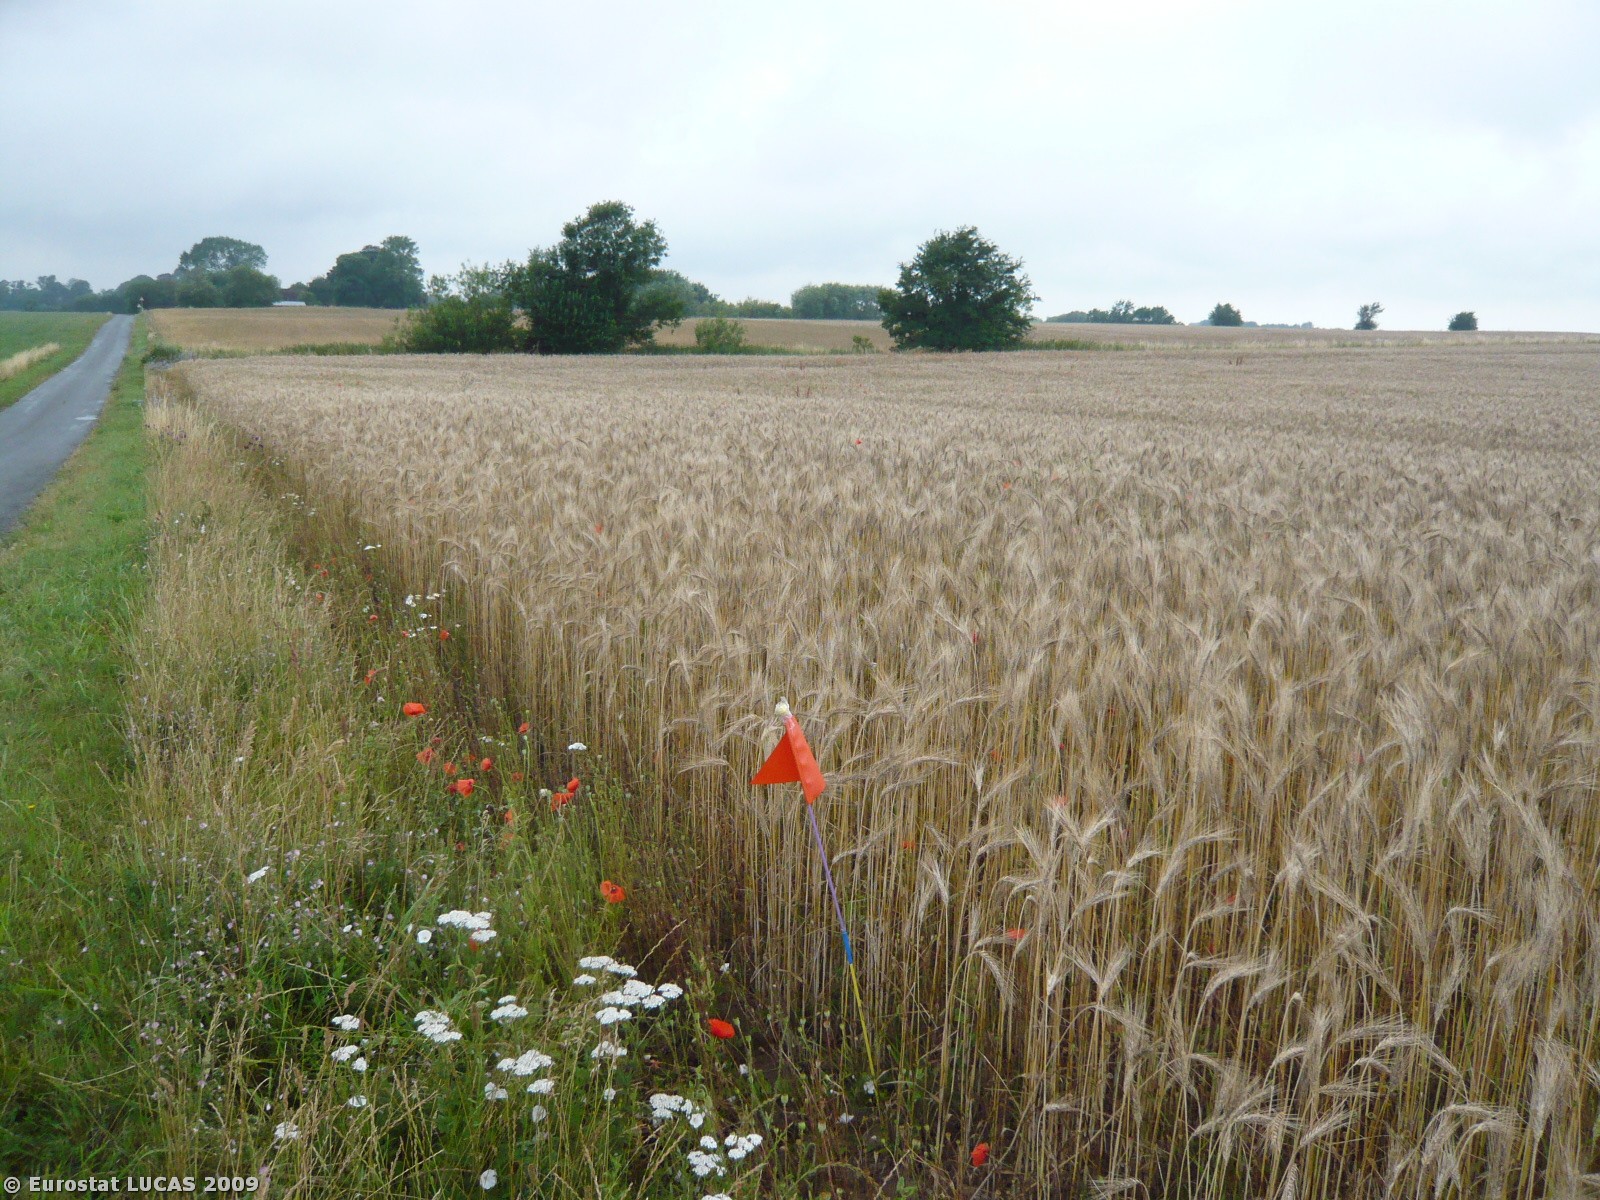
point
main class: Cropland
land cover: Durum wheat
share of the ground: > 75 %
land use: Agriculture (excluding fallow land and kitchen gardens)
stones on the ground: < 10 %
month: July
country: DK
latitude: 55.6699
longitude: 11.9221
